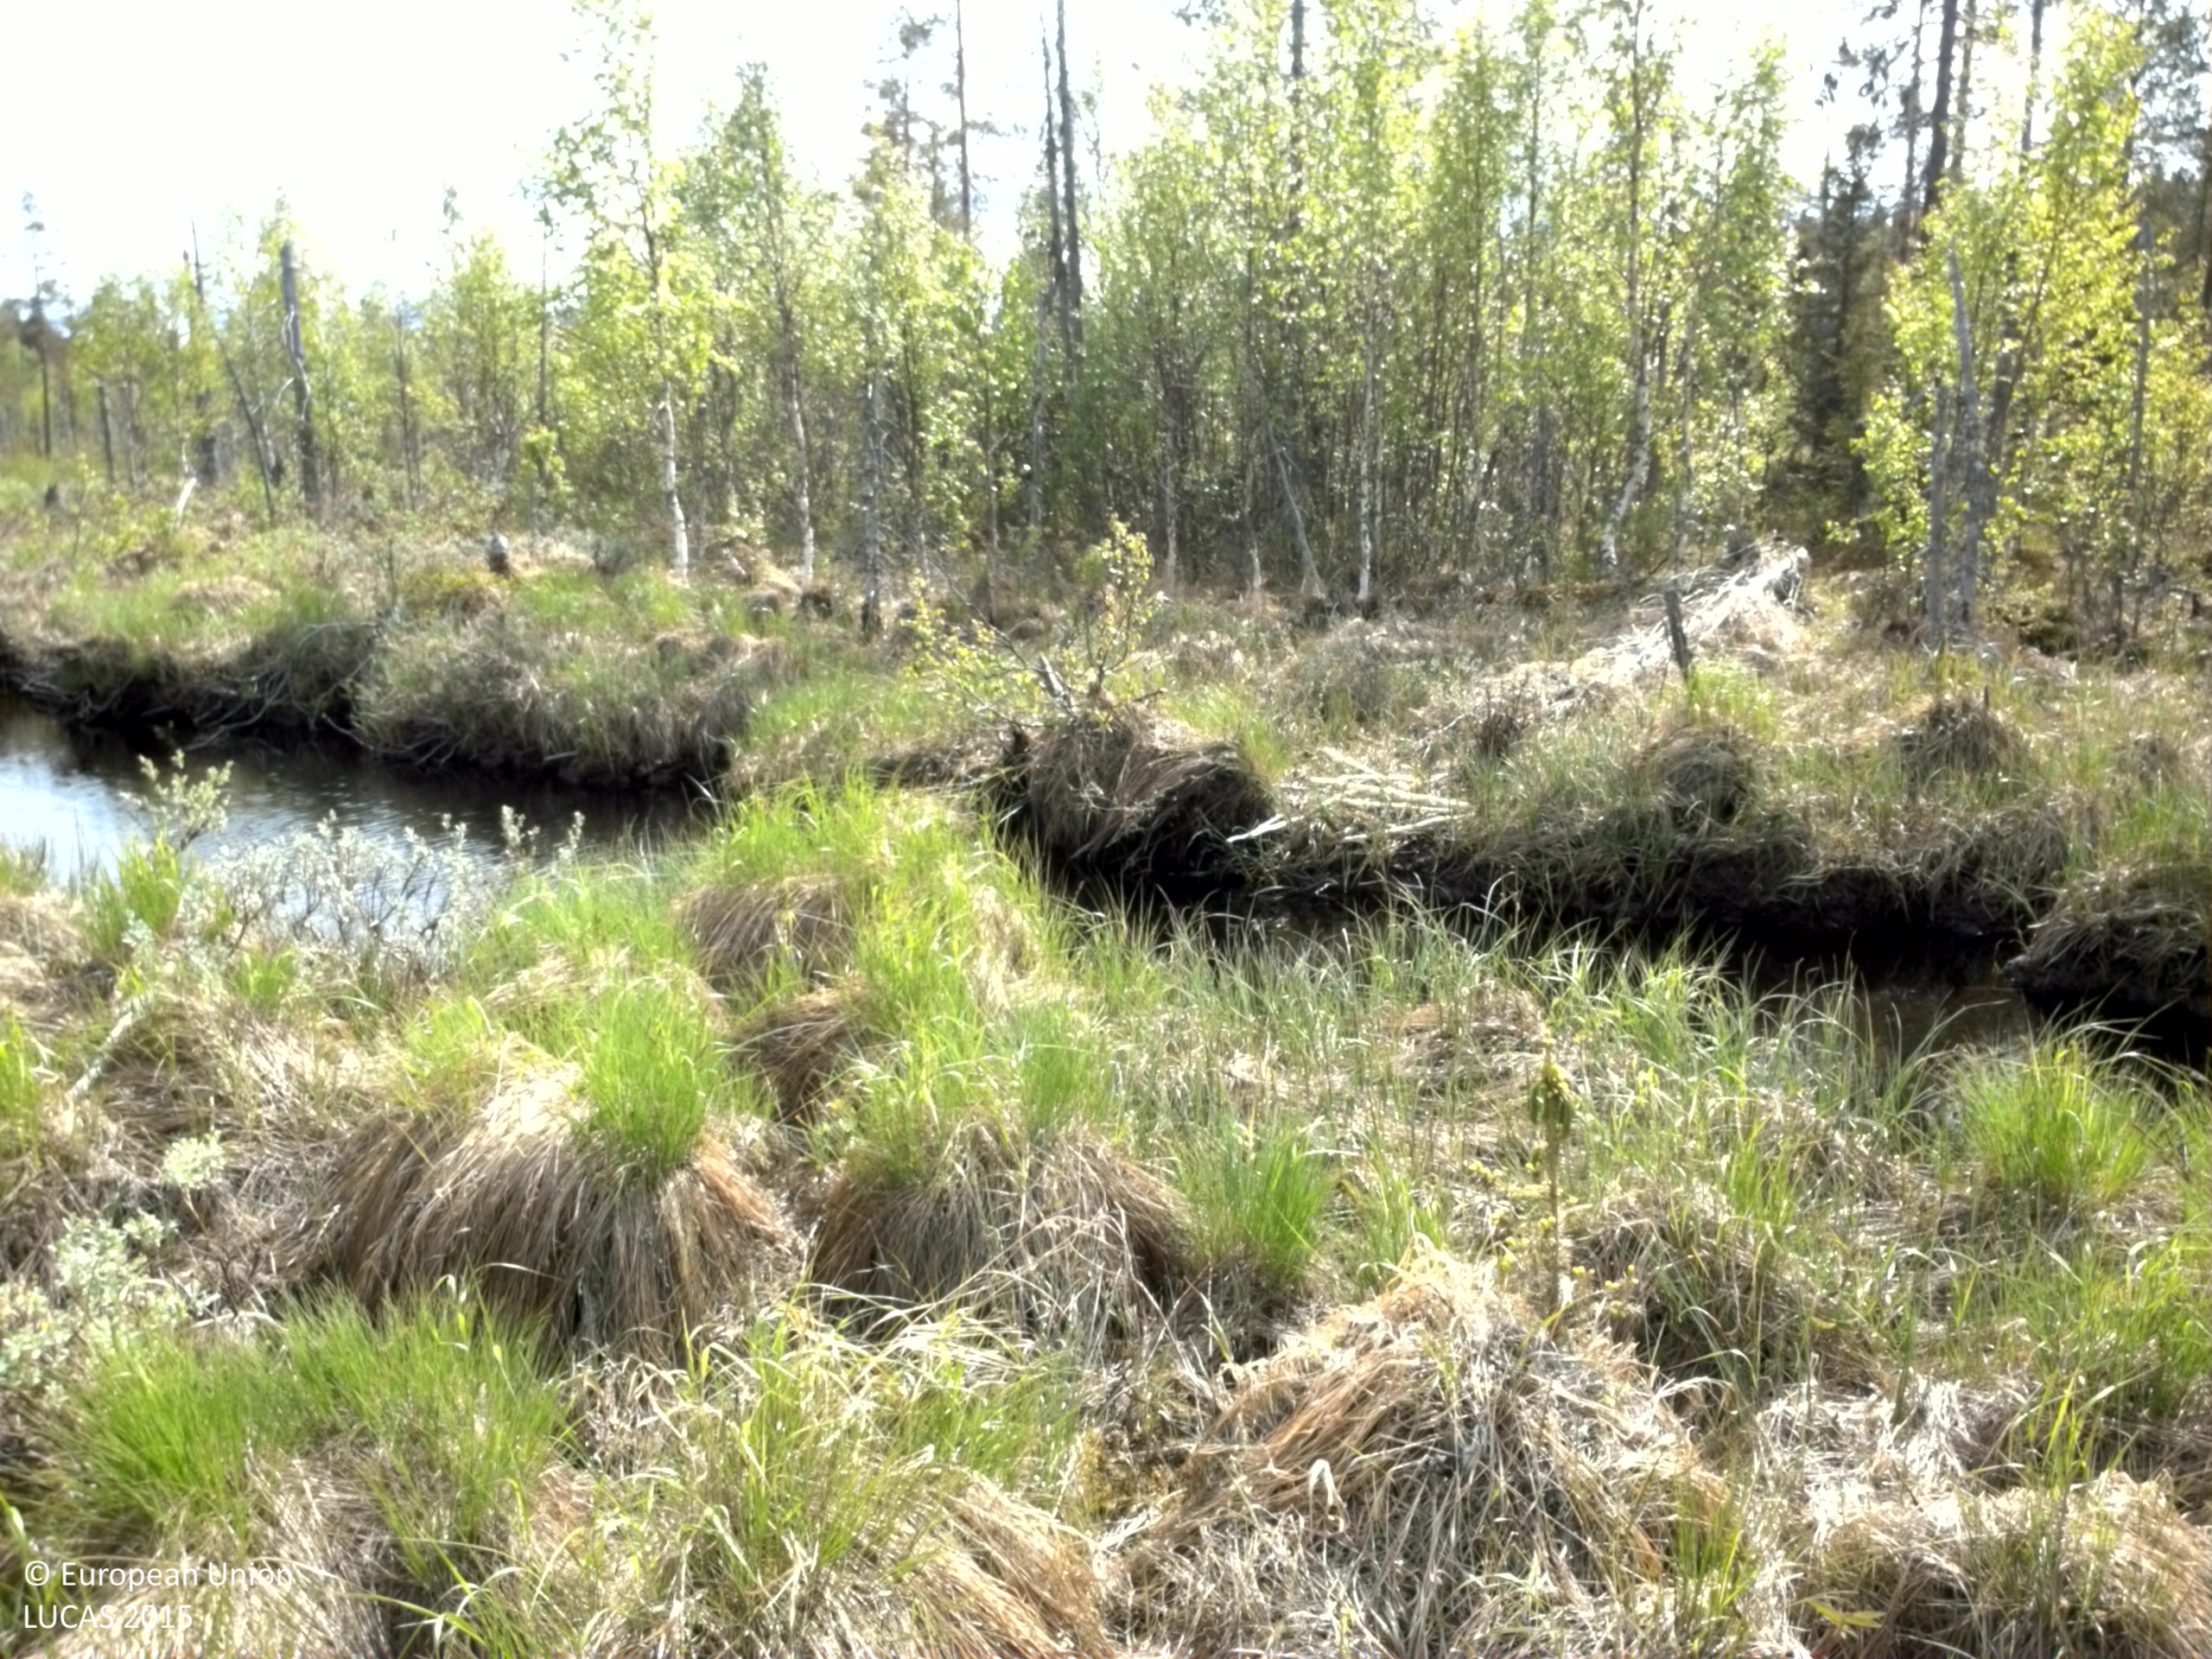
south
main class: Woodland
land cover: Pine dominated coniferous woodland
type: boreal forest
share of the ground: 25 - 50 %
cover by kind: coniferous forest trees 50 %, shrubs 30 %, herbaceous plants 20 %
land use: Forestry
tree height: > 5 m
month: June
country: SE
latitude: 63.2024
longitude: 17.9092
